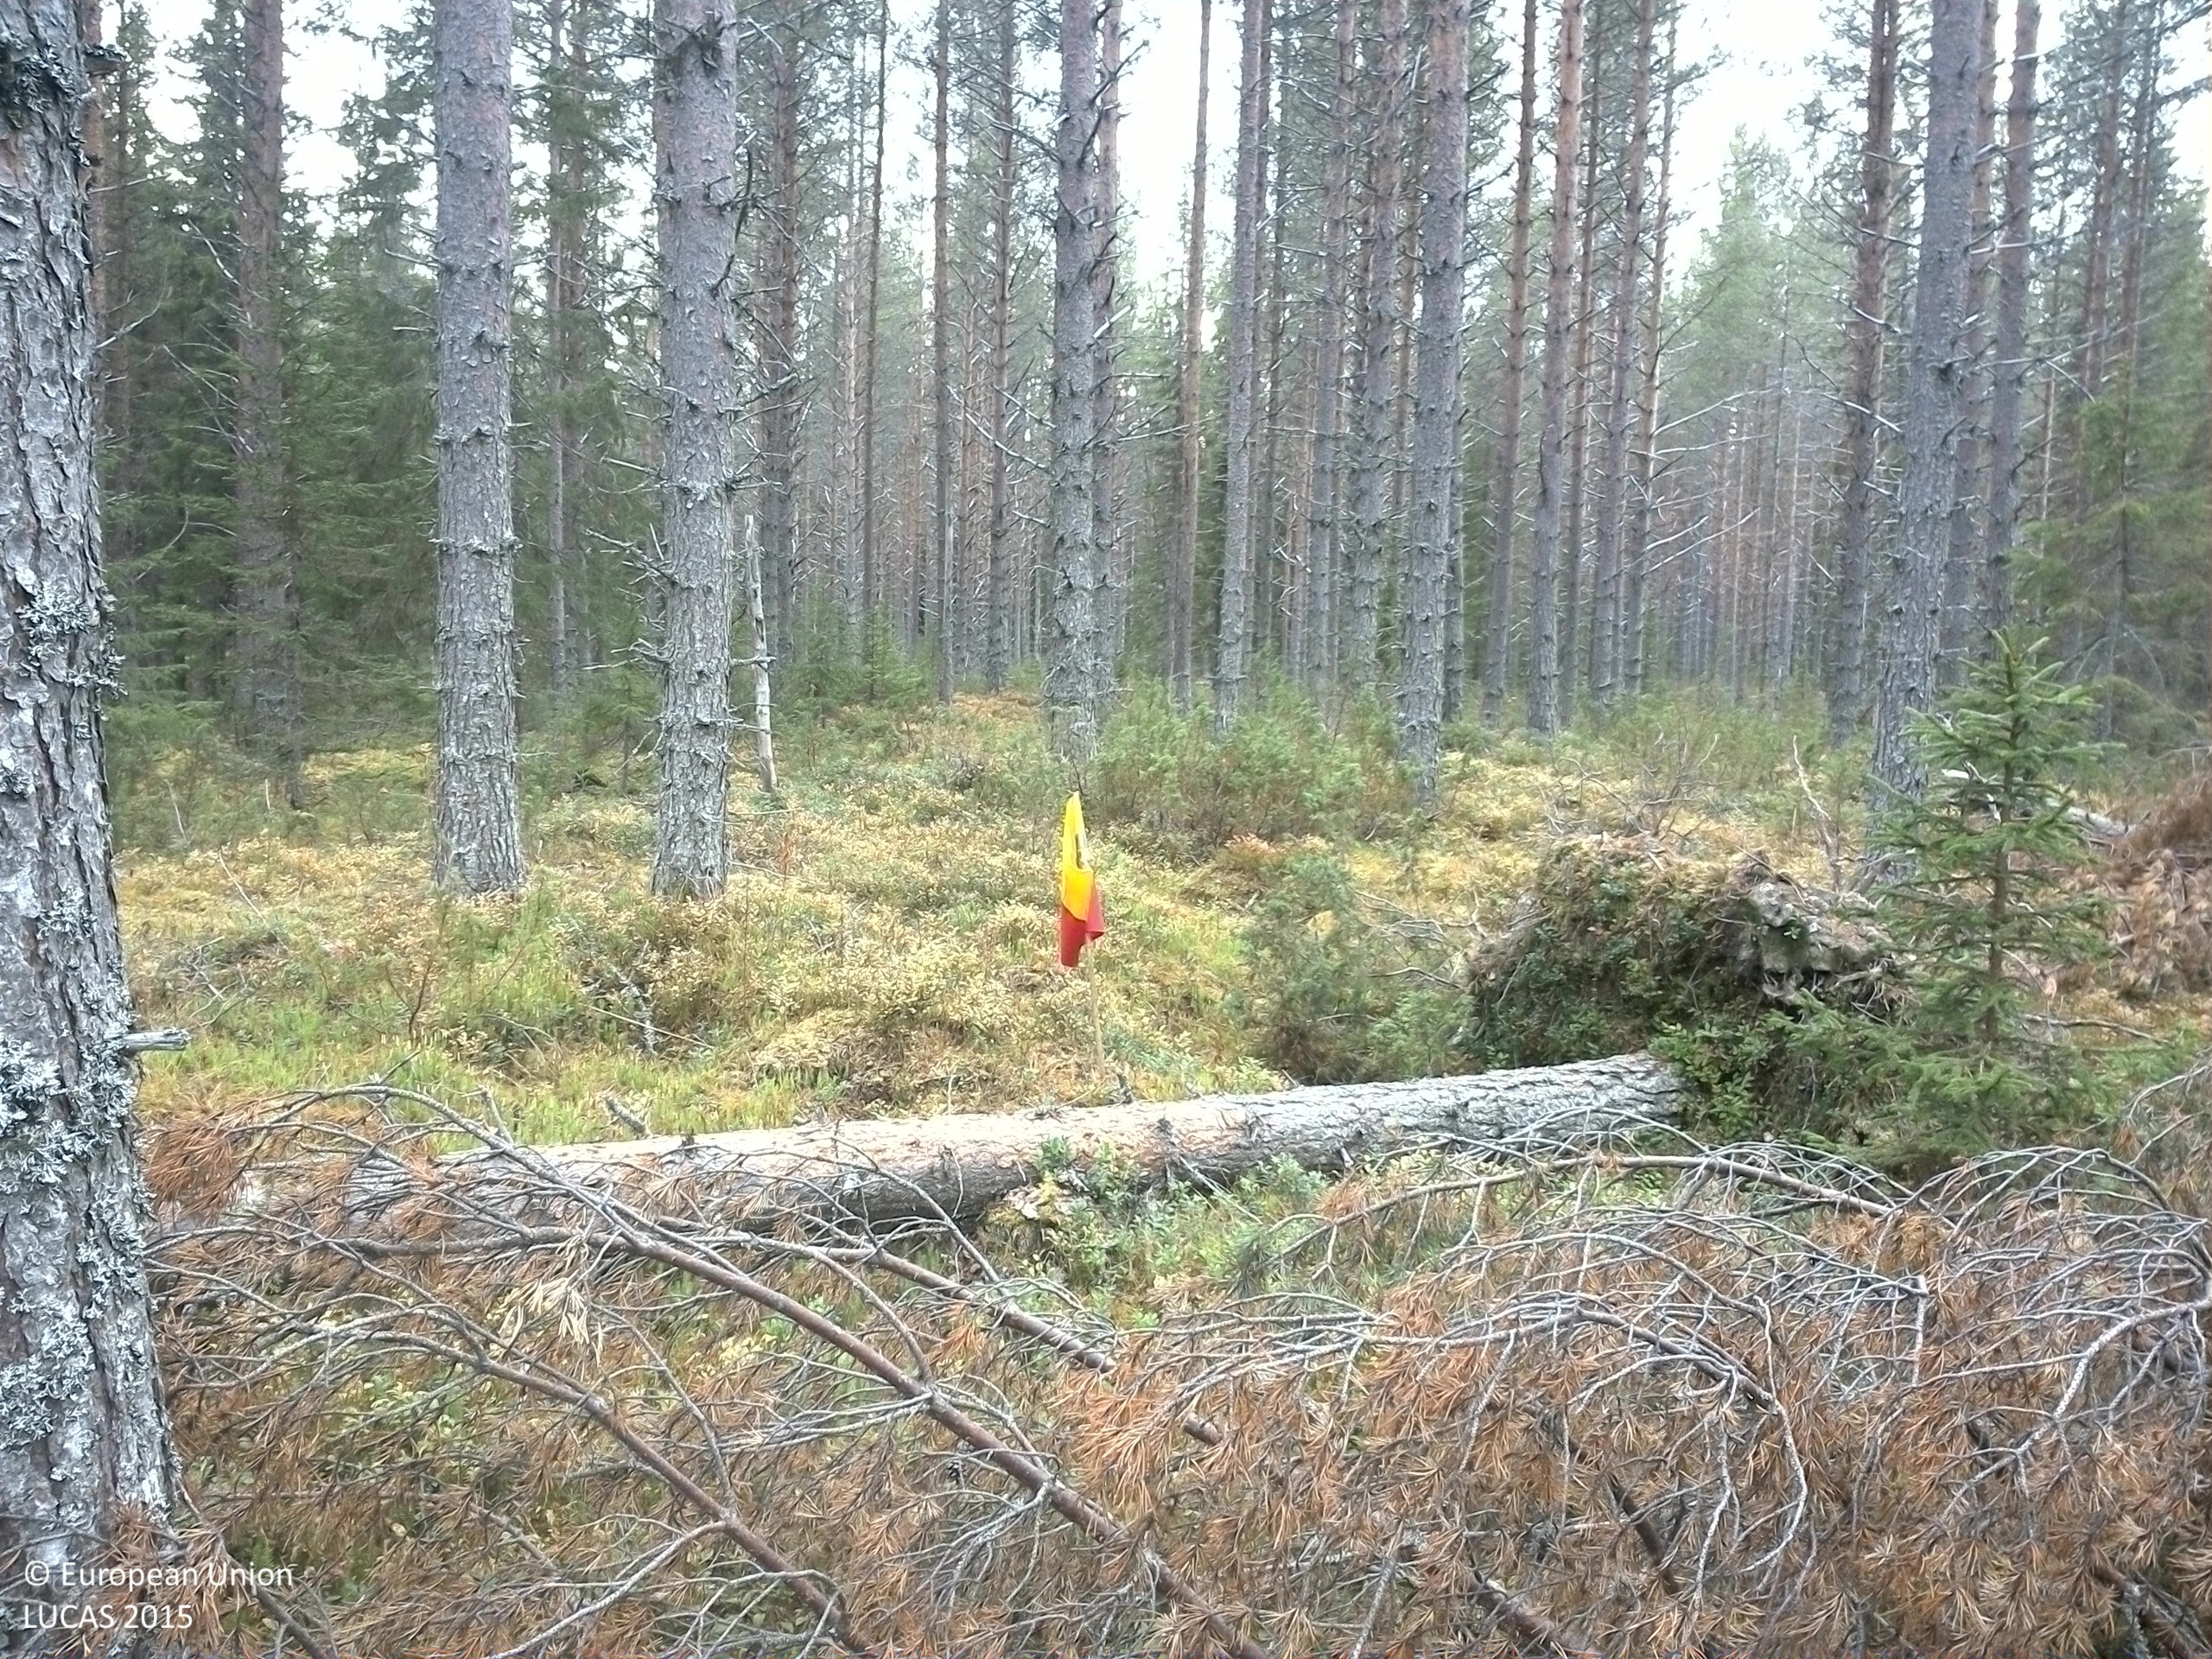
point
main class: Woodland
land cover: Pine dominated coniferous woodland
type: boreal forest
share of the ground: 25 - 50 %
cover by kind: shrubs 45 %, coniferous forest trees 40 %, lichens and mosses 15 %
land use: Forestry
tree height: > 5 m
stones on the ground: < 10 %
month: October
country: SE
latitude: 64.3528
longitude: 15.6236
